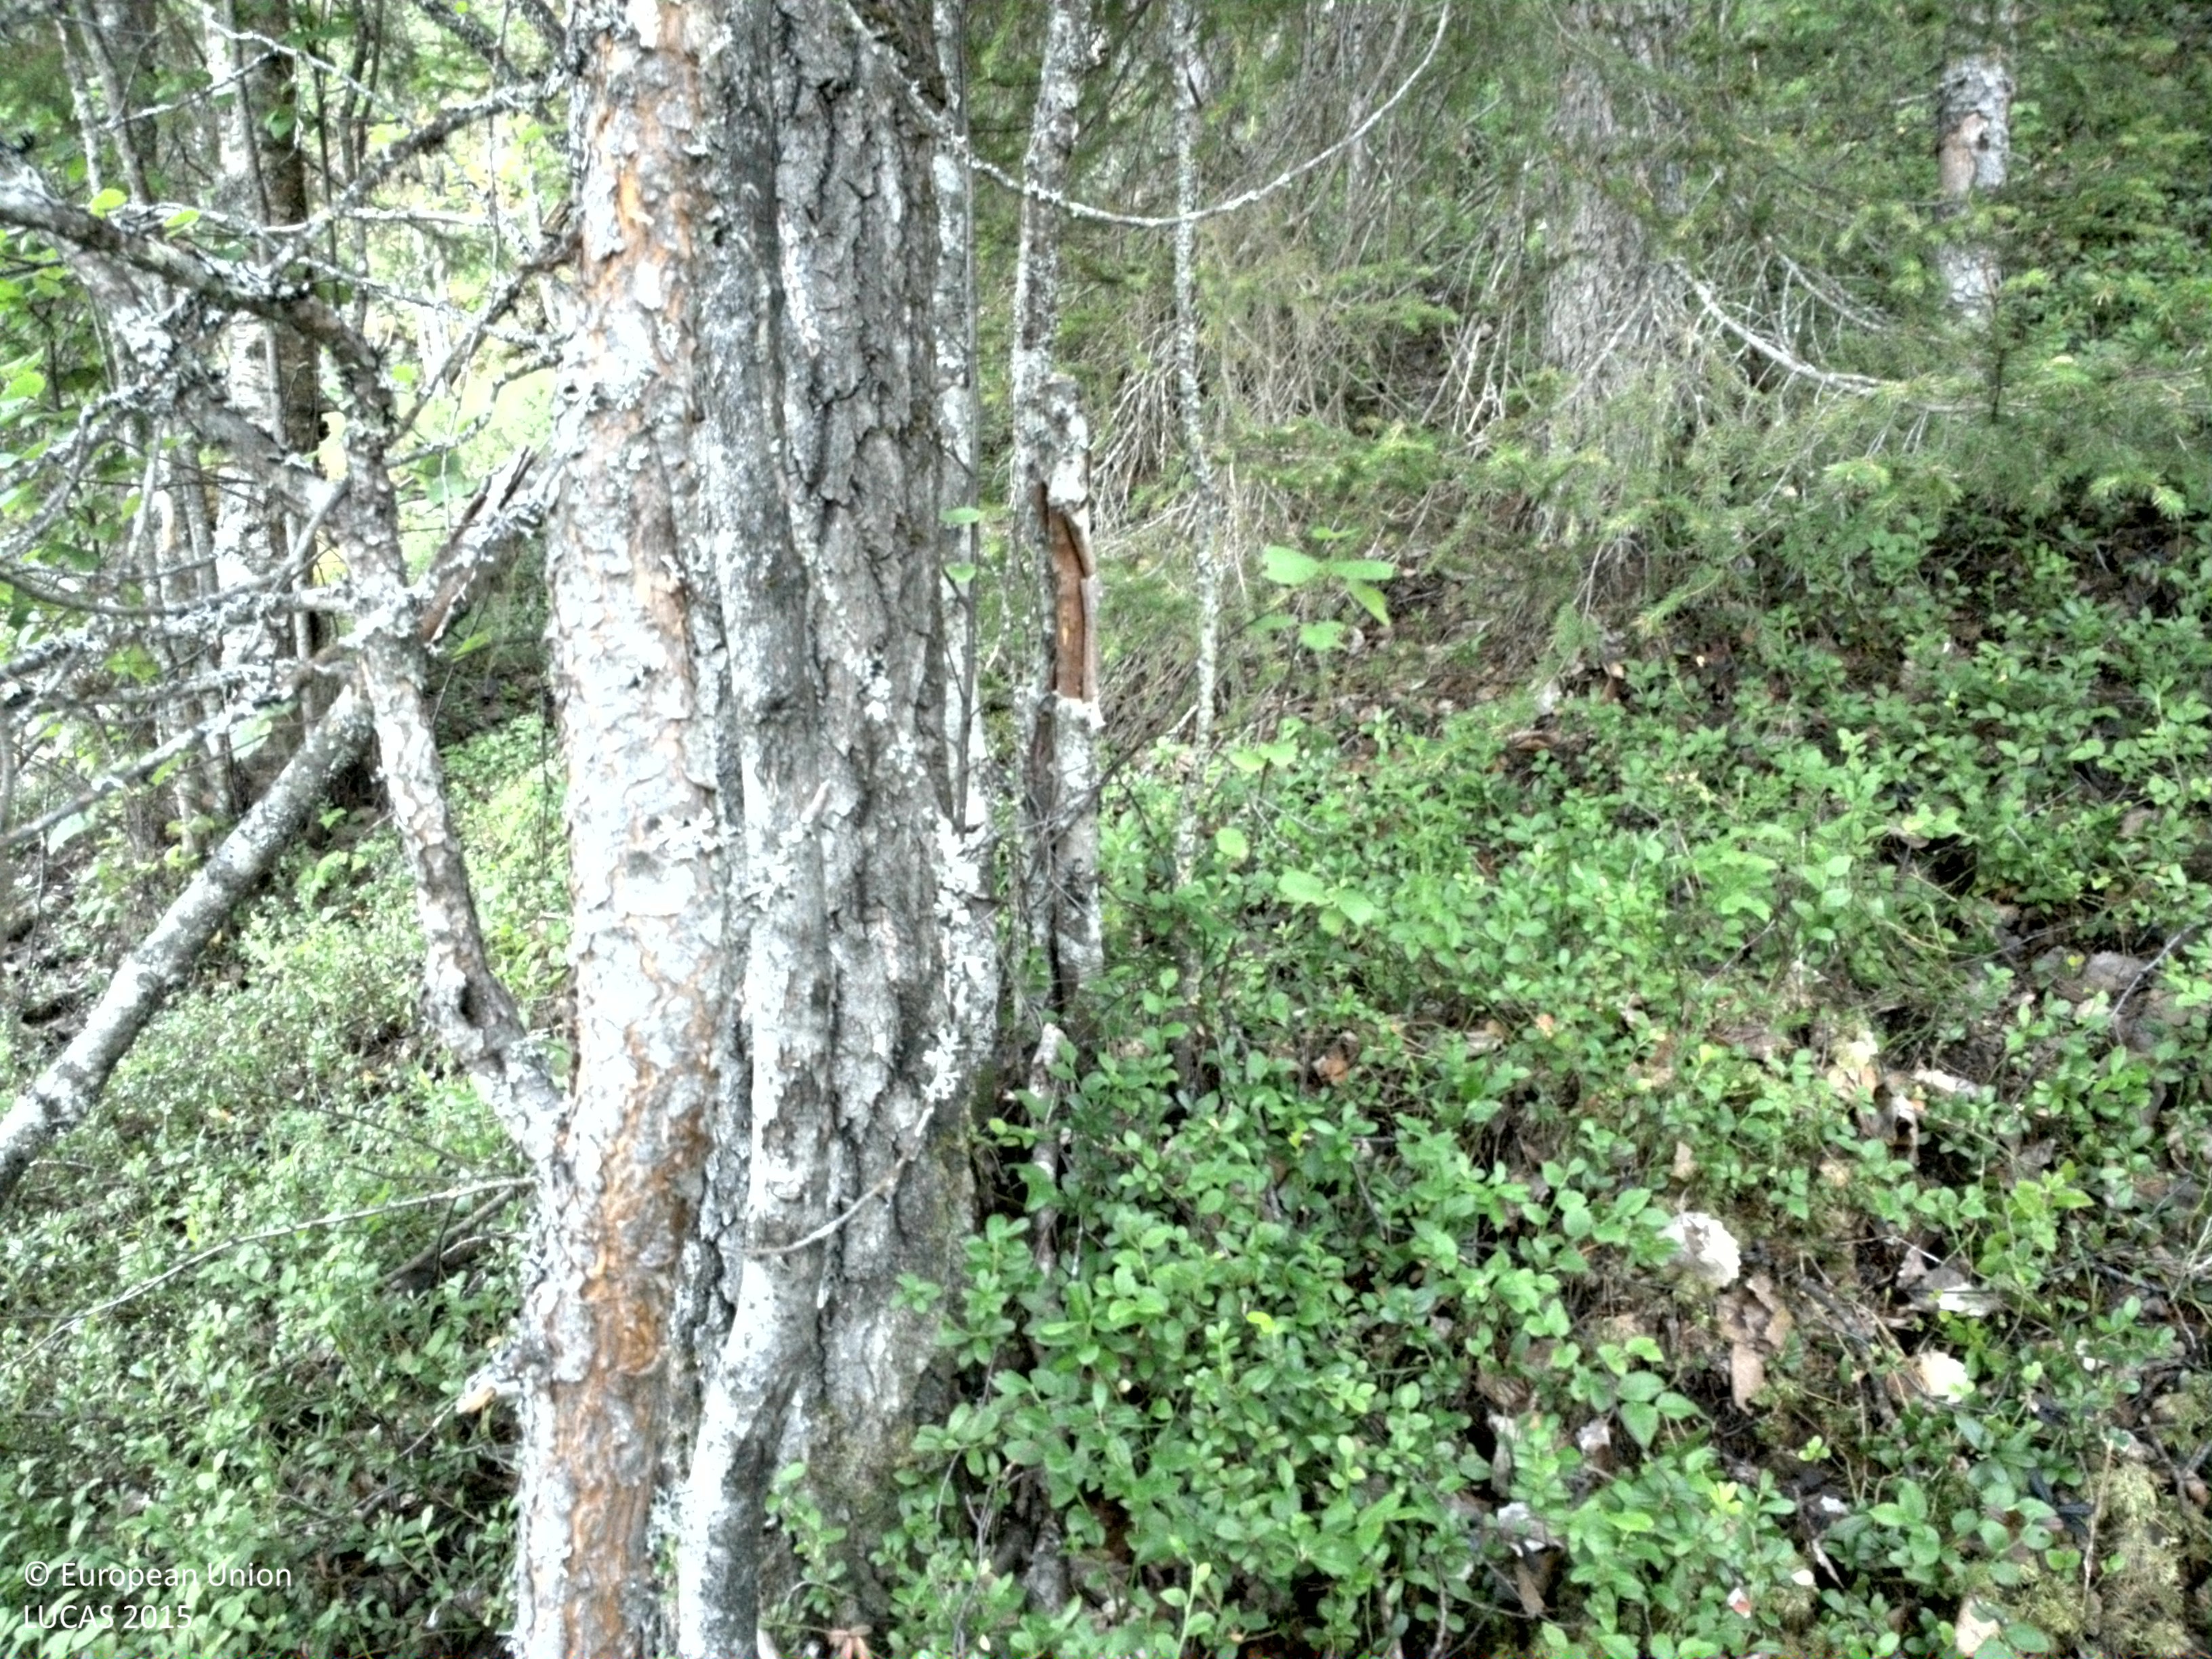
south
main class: Woodland
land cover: Broadleaved woodland
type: hemiboreal forest and nemoral coniferous forest and mixed broadleaved-coniferous forest
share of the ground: 25 - 50 %
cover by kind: shrubs 50 %, broadleaved forest trees 40 %, coniferous forest trees 5 %, consolidated bare surface 5 %
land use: Amenities, museums, leisure
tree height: < 5 m
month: August
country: SE
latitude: 66.3384
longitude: 20.6995
